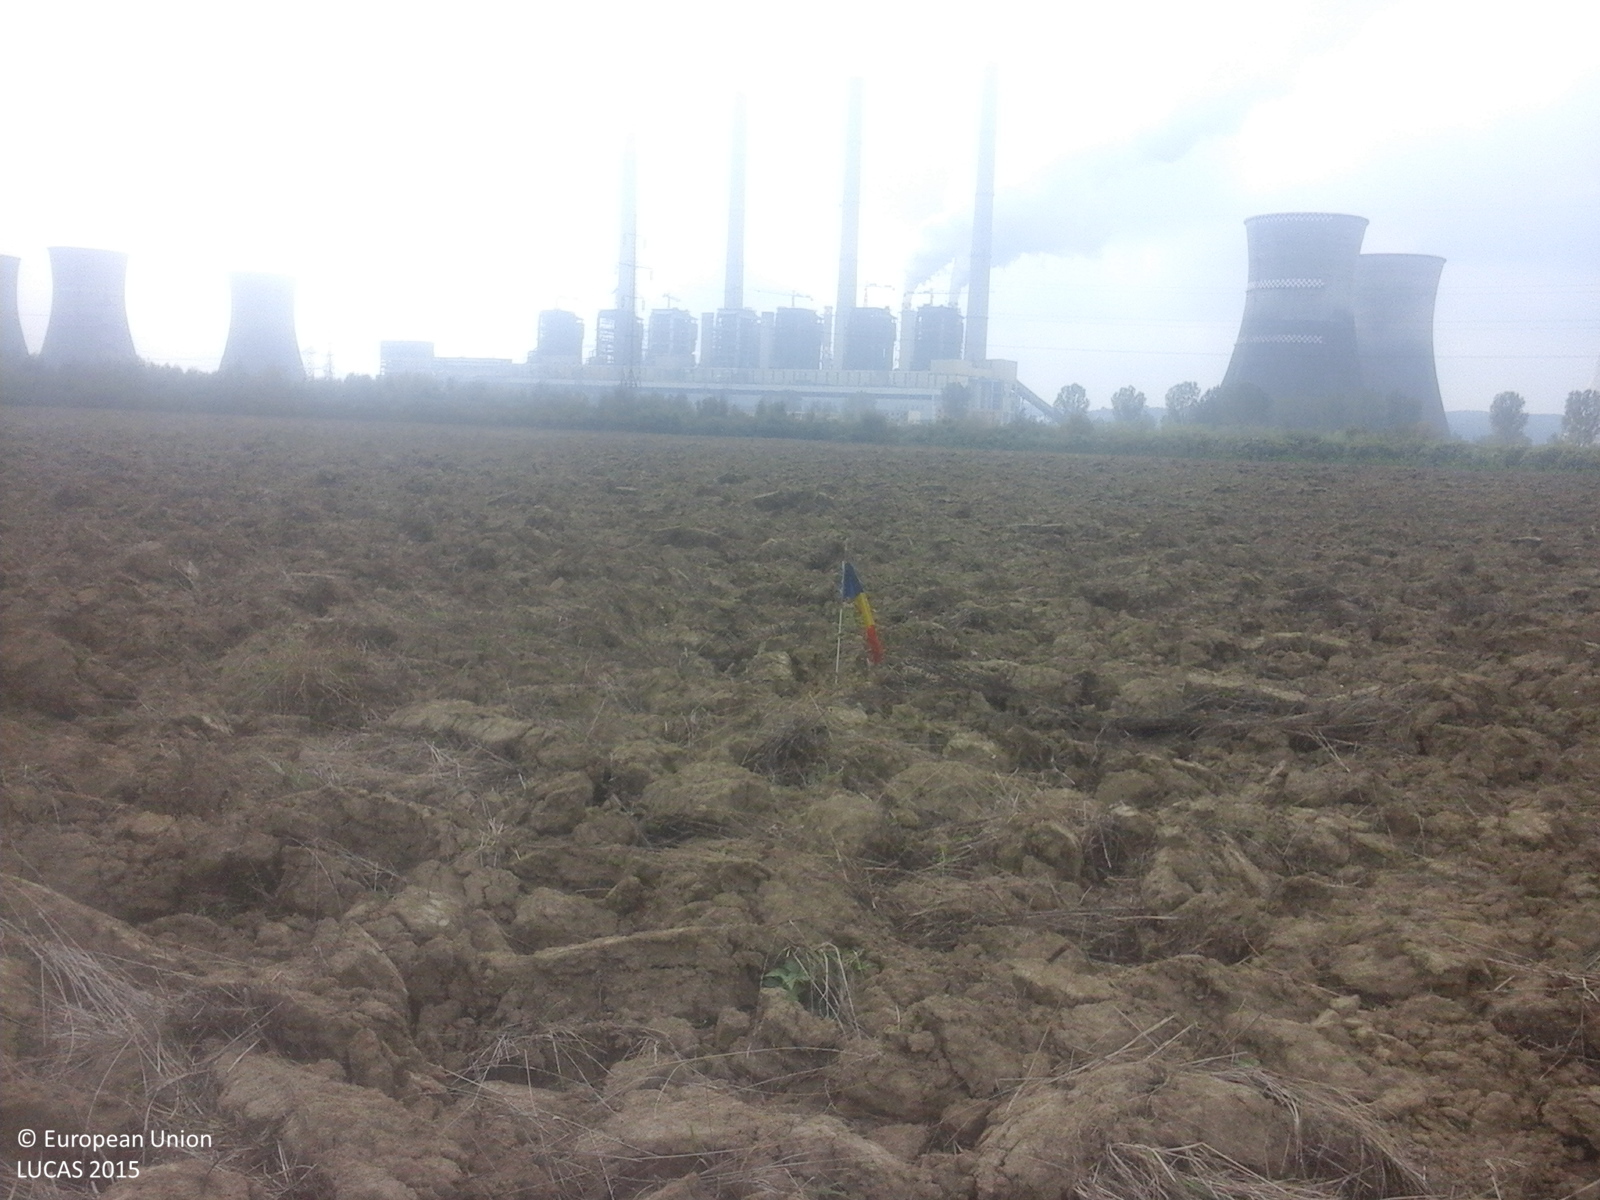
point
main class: Grassland
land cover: Grassland without tree/shrub cover
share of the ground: < 10 %
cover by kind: herbaceous plants 100 %
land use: Agriculture (excluding fallow land and kitchen gardens)
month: September
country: RO
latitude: 44.6804
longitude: 23.4136
